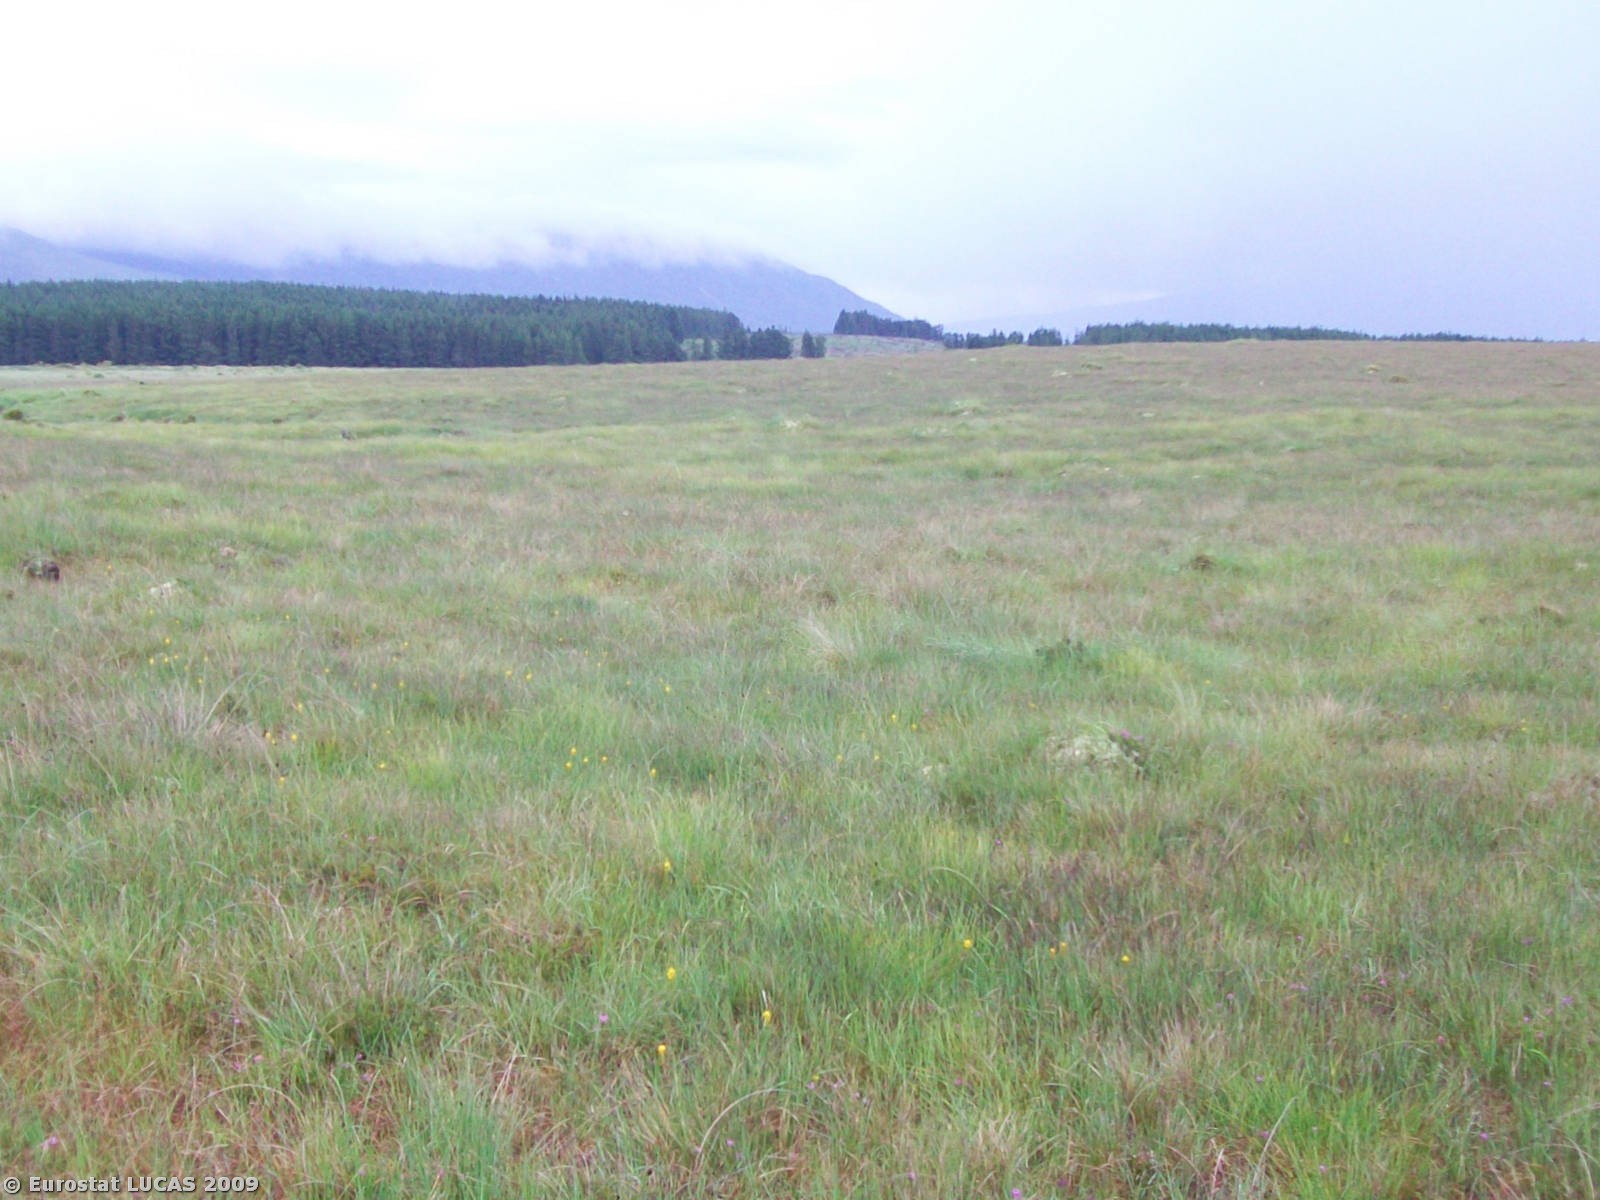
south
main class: Wetlands
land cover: Peatbogs
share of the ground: > 75 %
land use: Unused
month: July
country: IE
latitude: 53.9955
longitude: -9.7522
